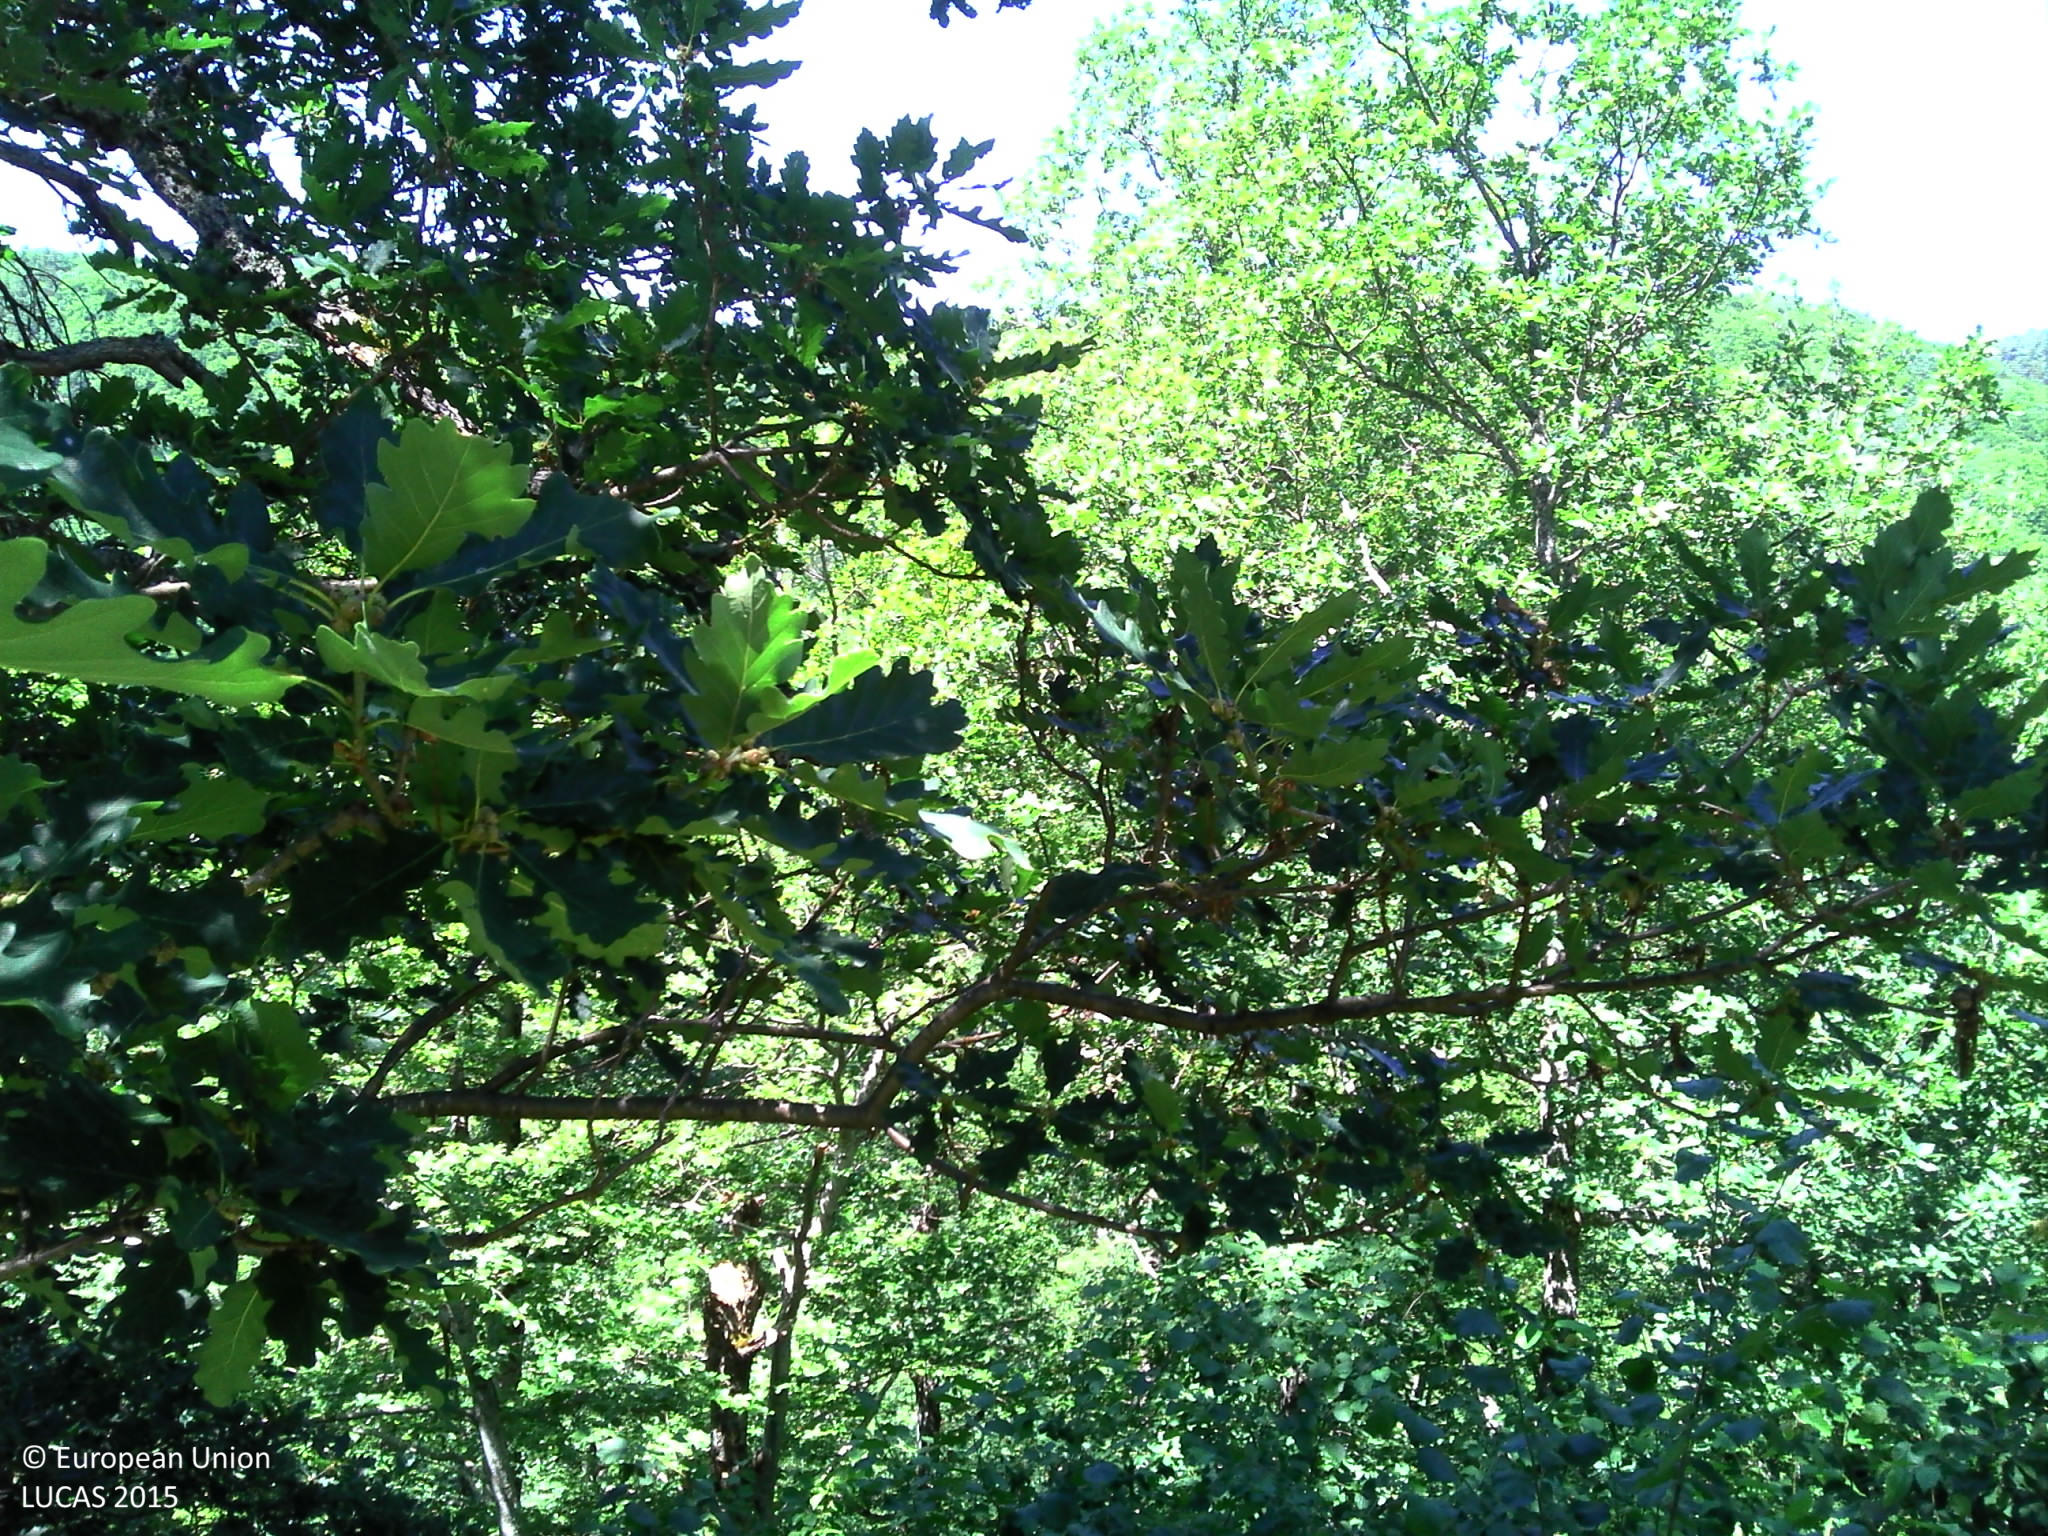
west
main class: Woodland
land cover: Broadleaved woodland
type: mesophytic deciduous forest
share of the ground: > 75 %
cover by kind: broadleaved forest trees 100 %
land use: Semi-natural and natural areas not in use
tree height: > 5 m
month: July
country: FR
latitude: 42.6926
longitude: 2.1373
